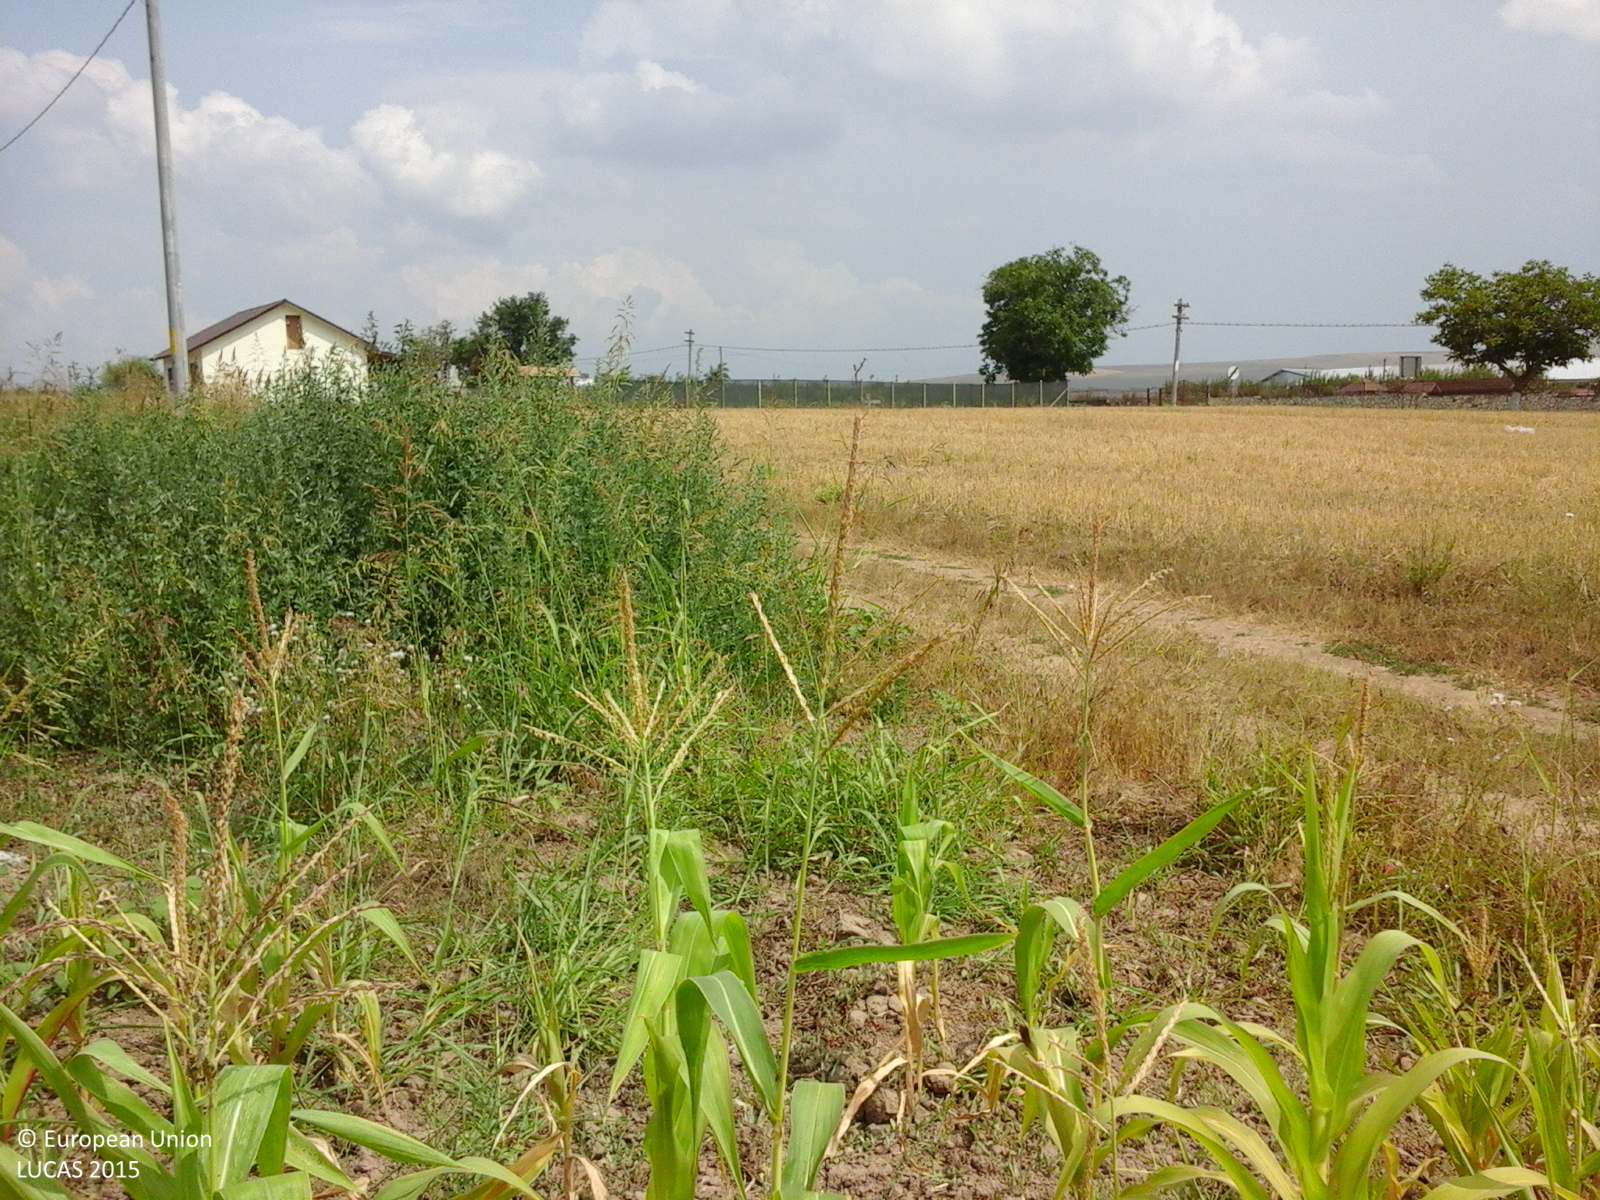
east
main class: Cropland
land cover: Maize
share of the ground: > 75 %
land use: Agriculture (excluding fallow land and kitchen gardens)
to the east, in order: Maize; Tracks; Common wheat; Electric lines; Common wheat; Artificial constructions in urban areas; Common wheat; Ditches and canals; Electric lines; Artificial constructions in urban areas
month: July
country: RO
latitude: 45.1021
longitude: 28.7301
